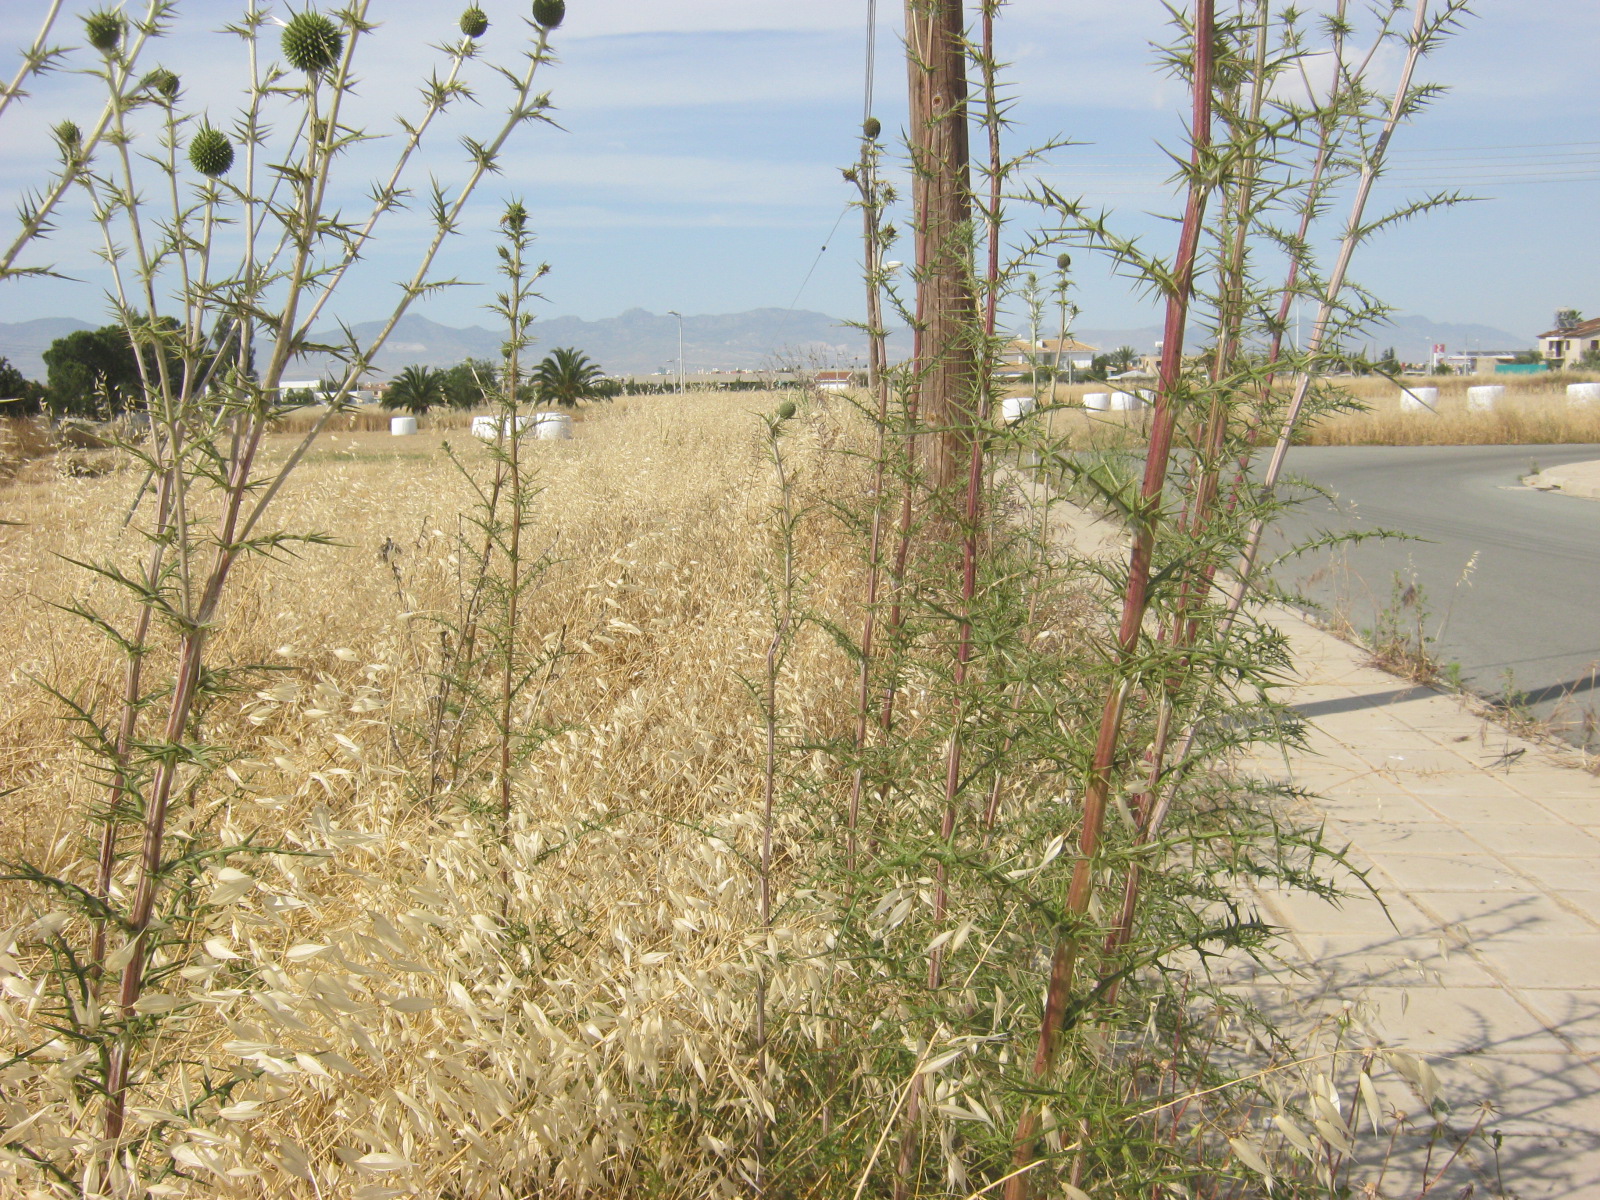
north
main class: Grassland
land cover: Spontaneously vegetated surfaces
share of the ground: > 75 %
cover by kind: herbaceous plants 100 %
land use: Agriculture (excluding fallow land and kitchen gardens)
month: May
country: CY
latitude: 35.1037
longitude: 33.3274
